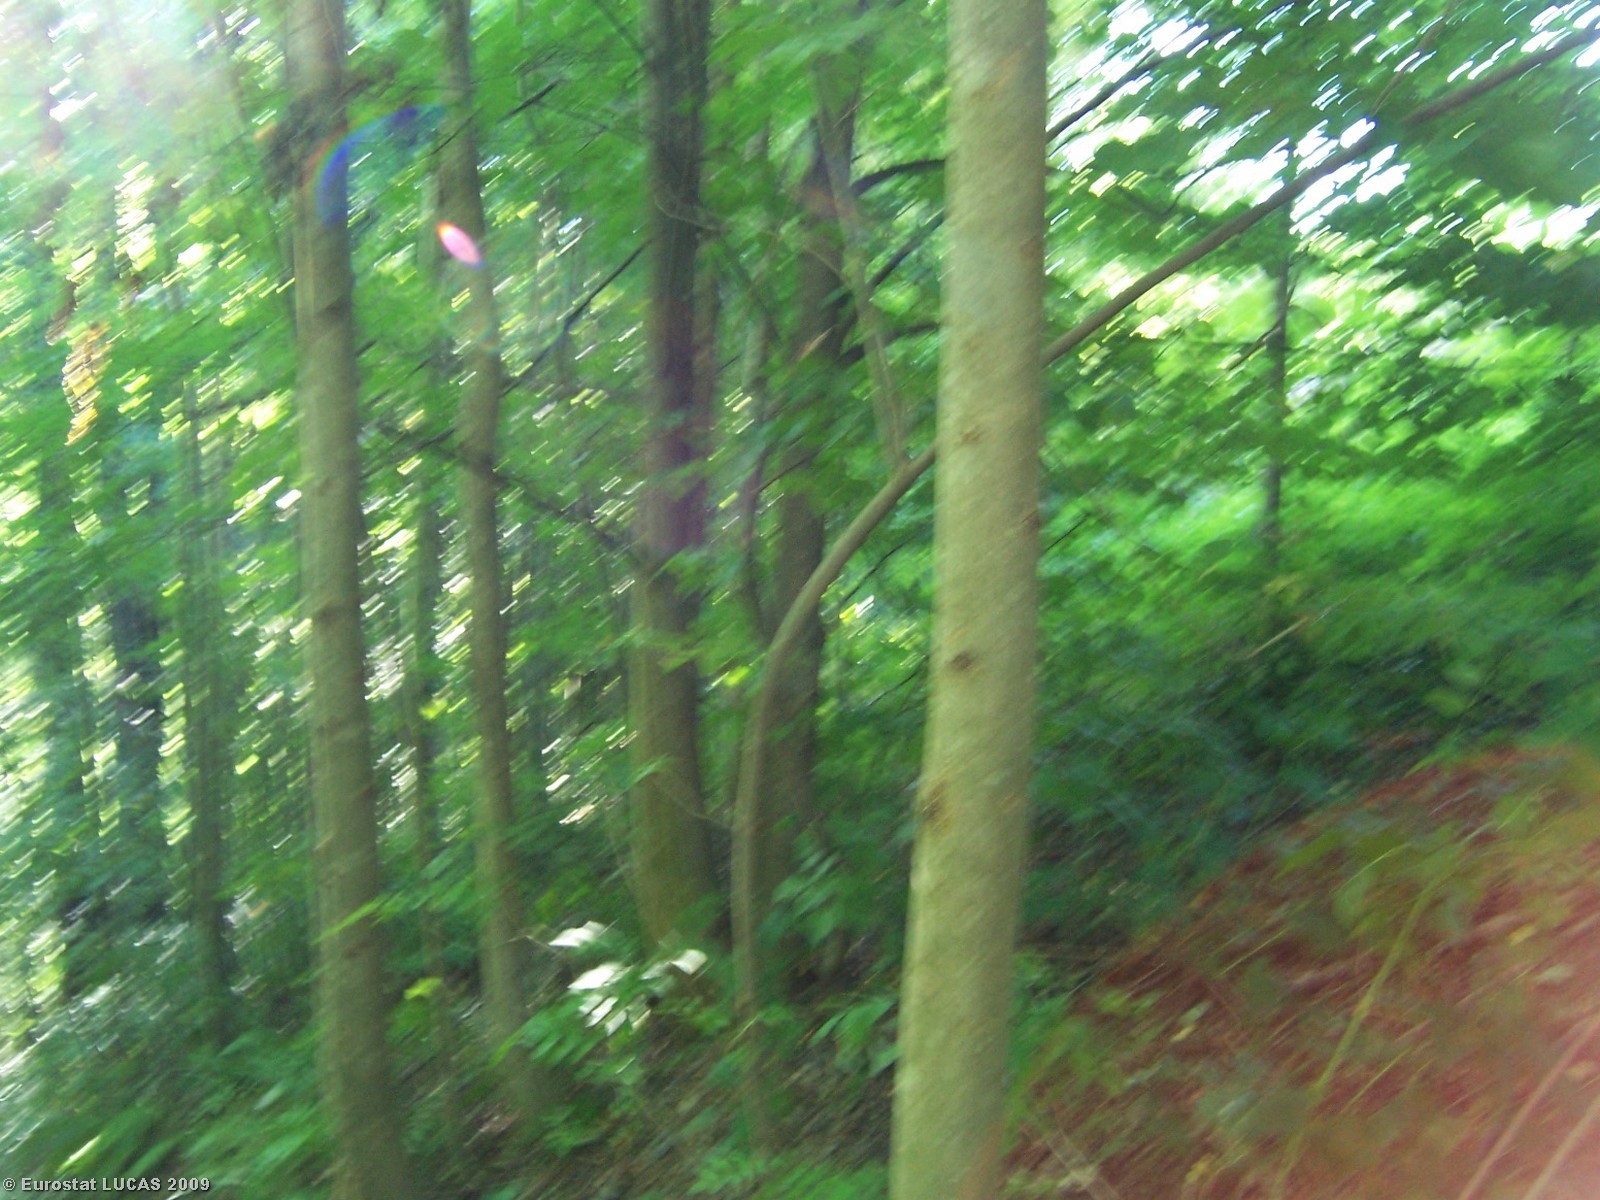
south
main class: Woodland
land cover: Broadleaved woodland
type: mesophytic deciduous forest
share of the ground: > 75 %
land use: Unused
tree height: > 5 m
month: July
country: IT
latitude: 45.3099
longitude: 7.3894
